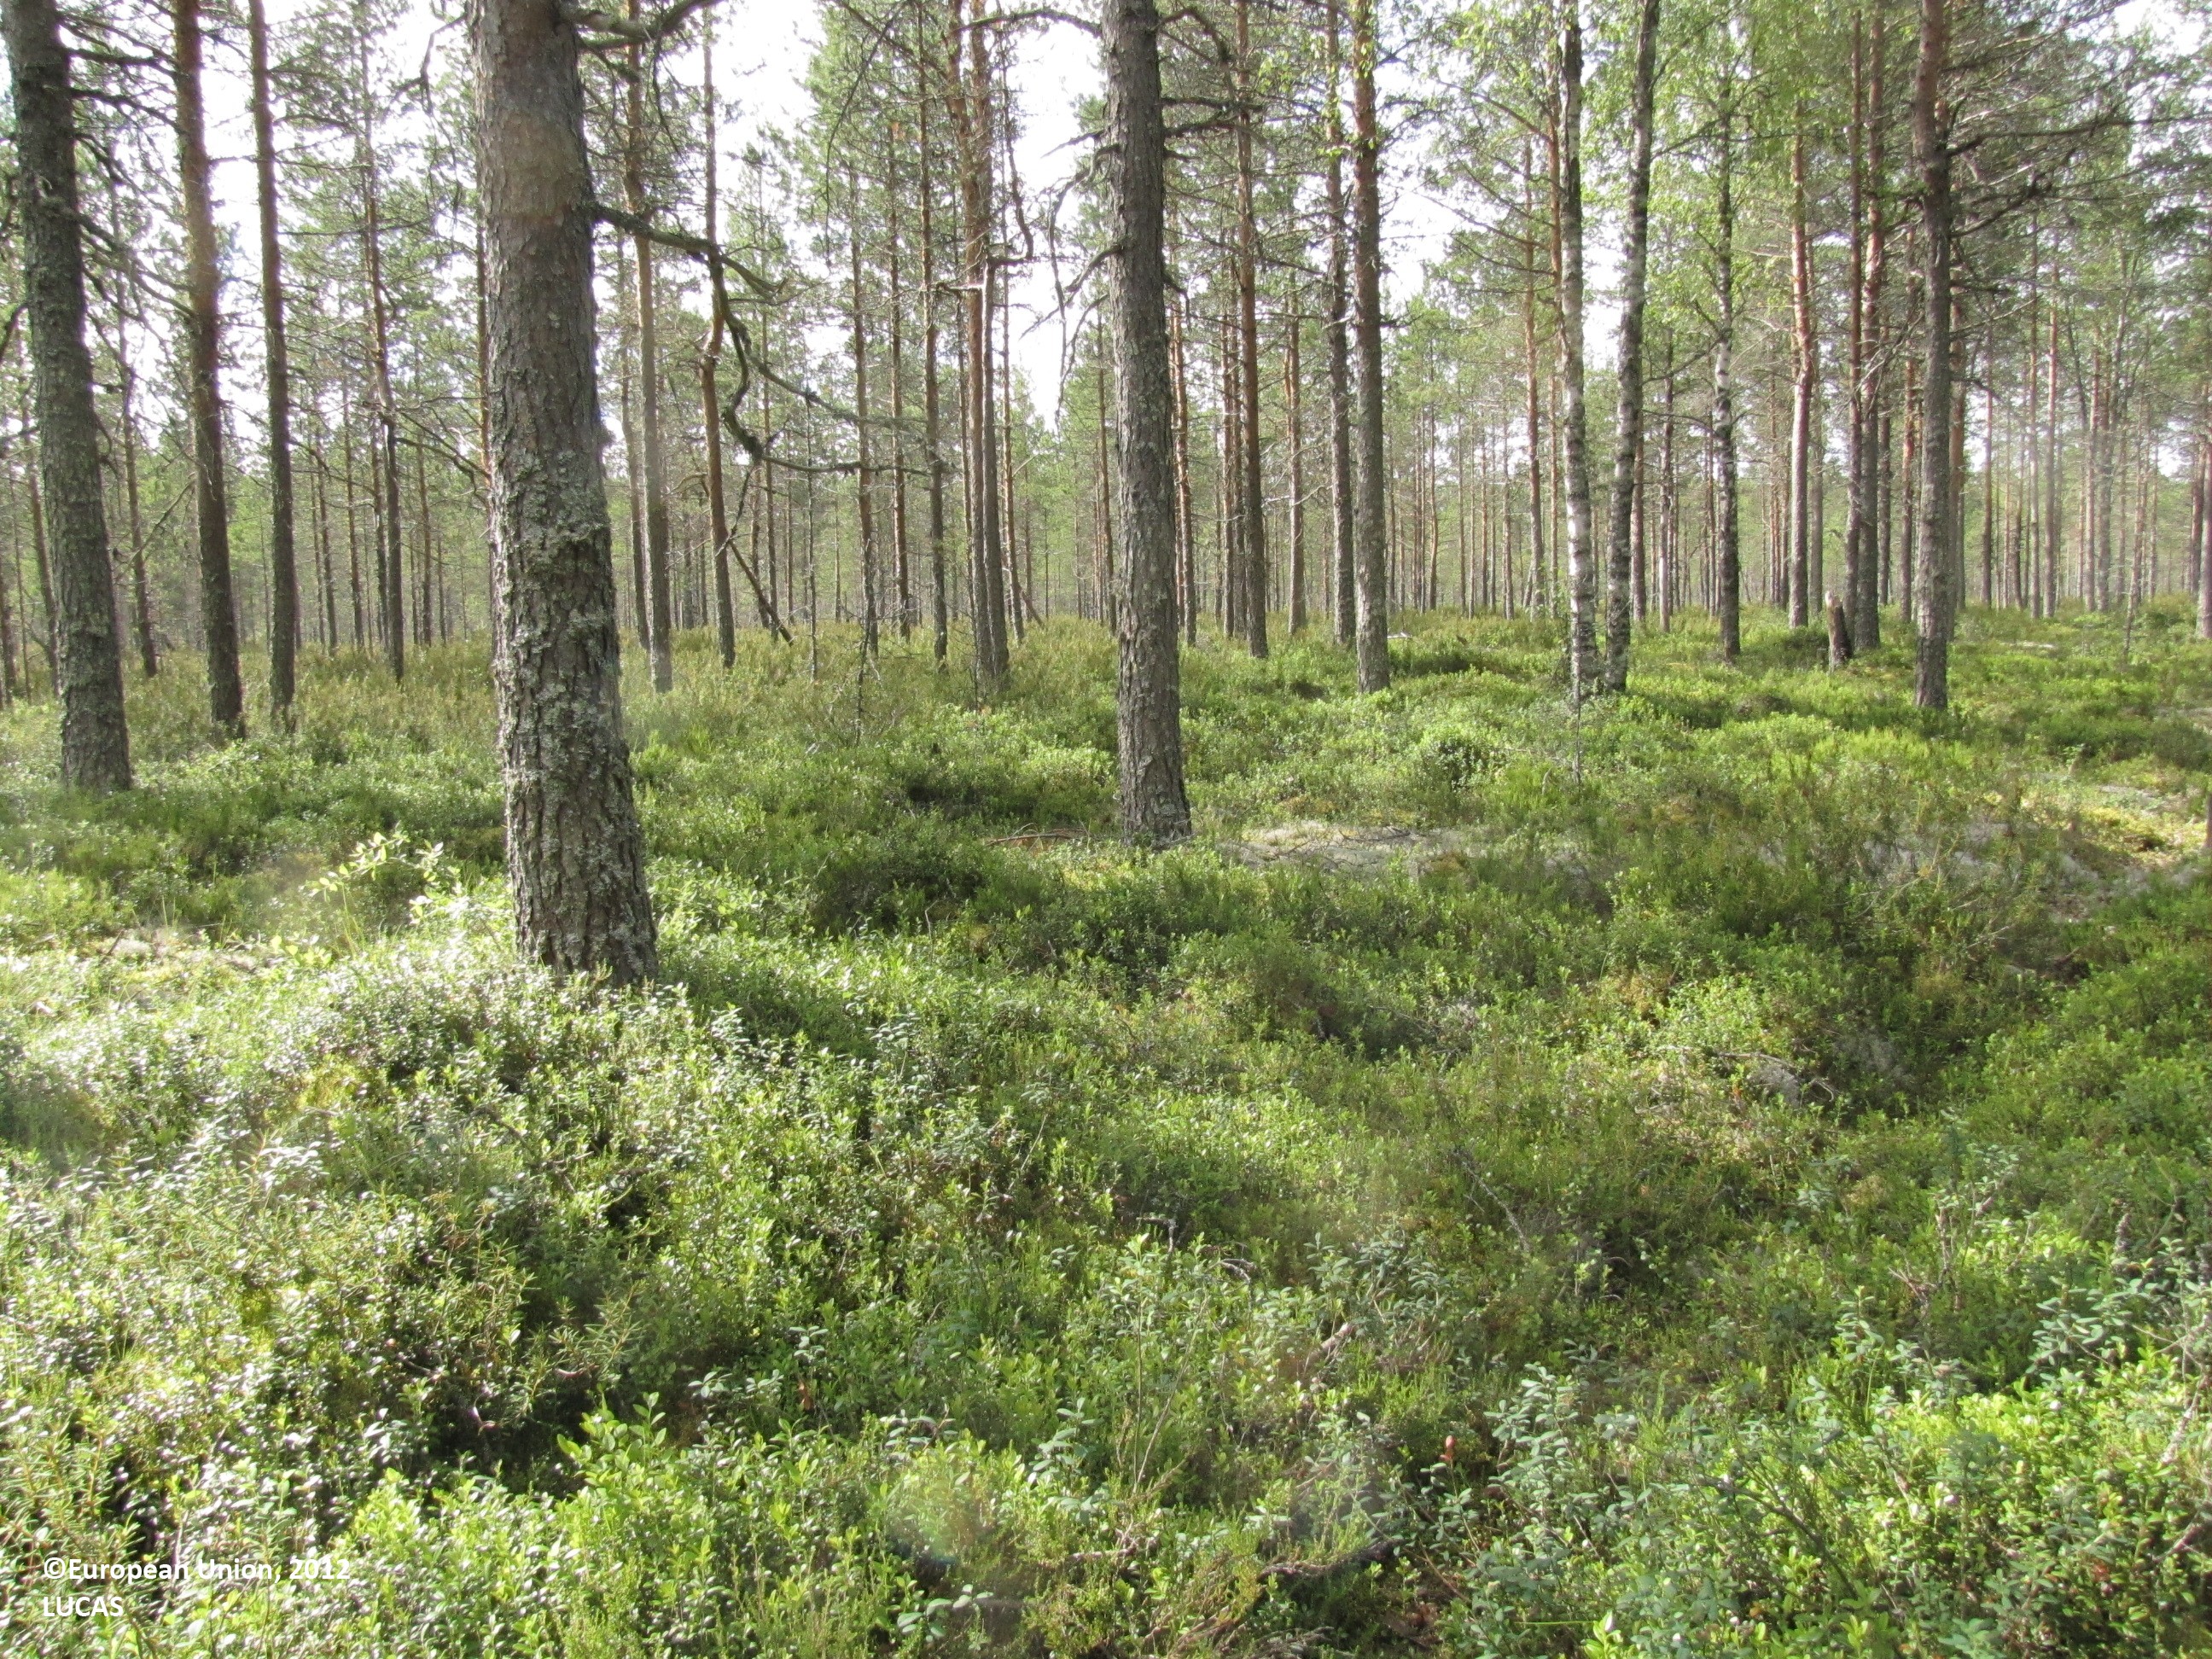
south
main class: Woodland
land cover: Pine dominated coniferous woodland
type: mire and swamp forests
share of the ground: 50 - 75 %
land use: Forestry
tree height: > 5 m
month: July
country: FI
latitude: 62.3978
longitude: 23.1639
